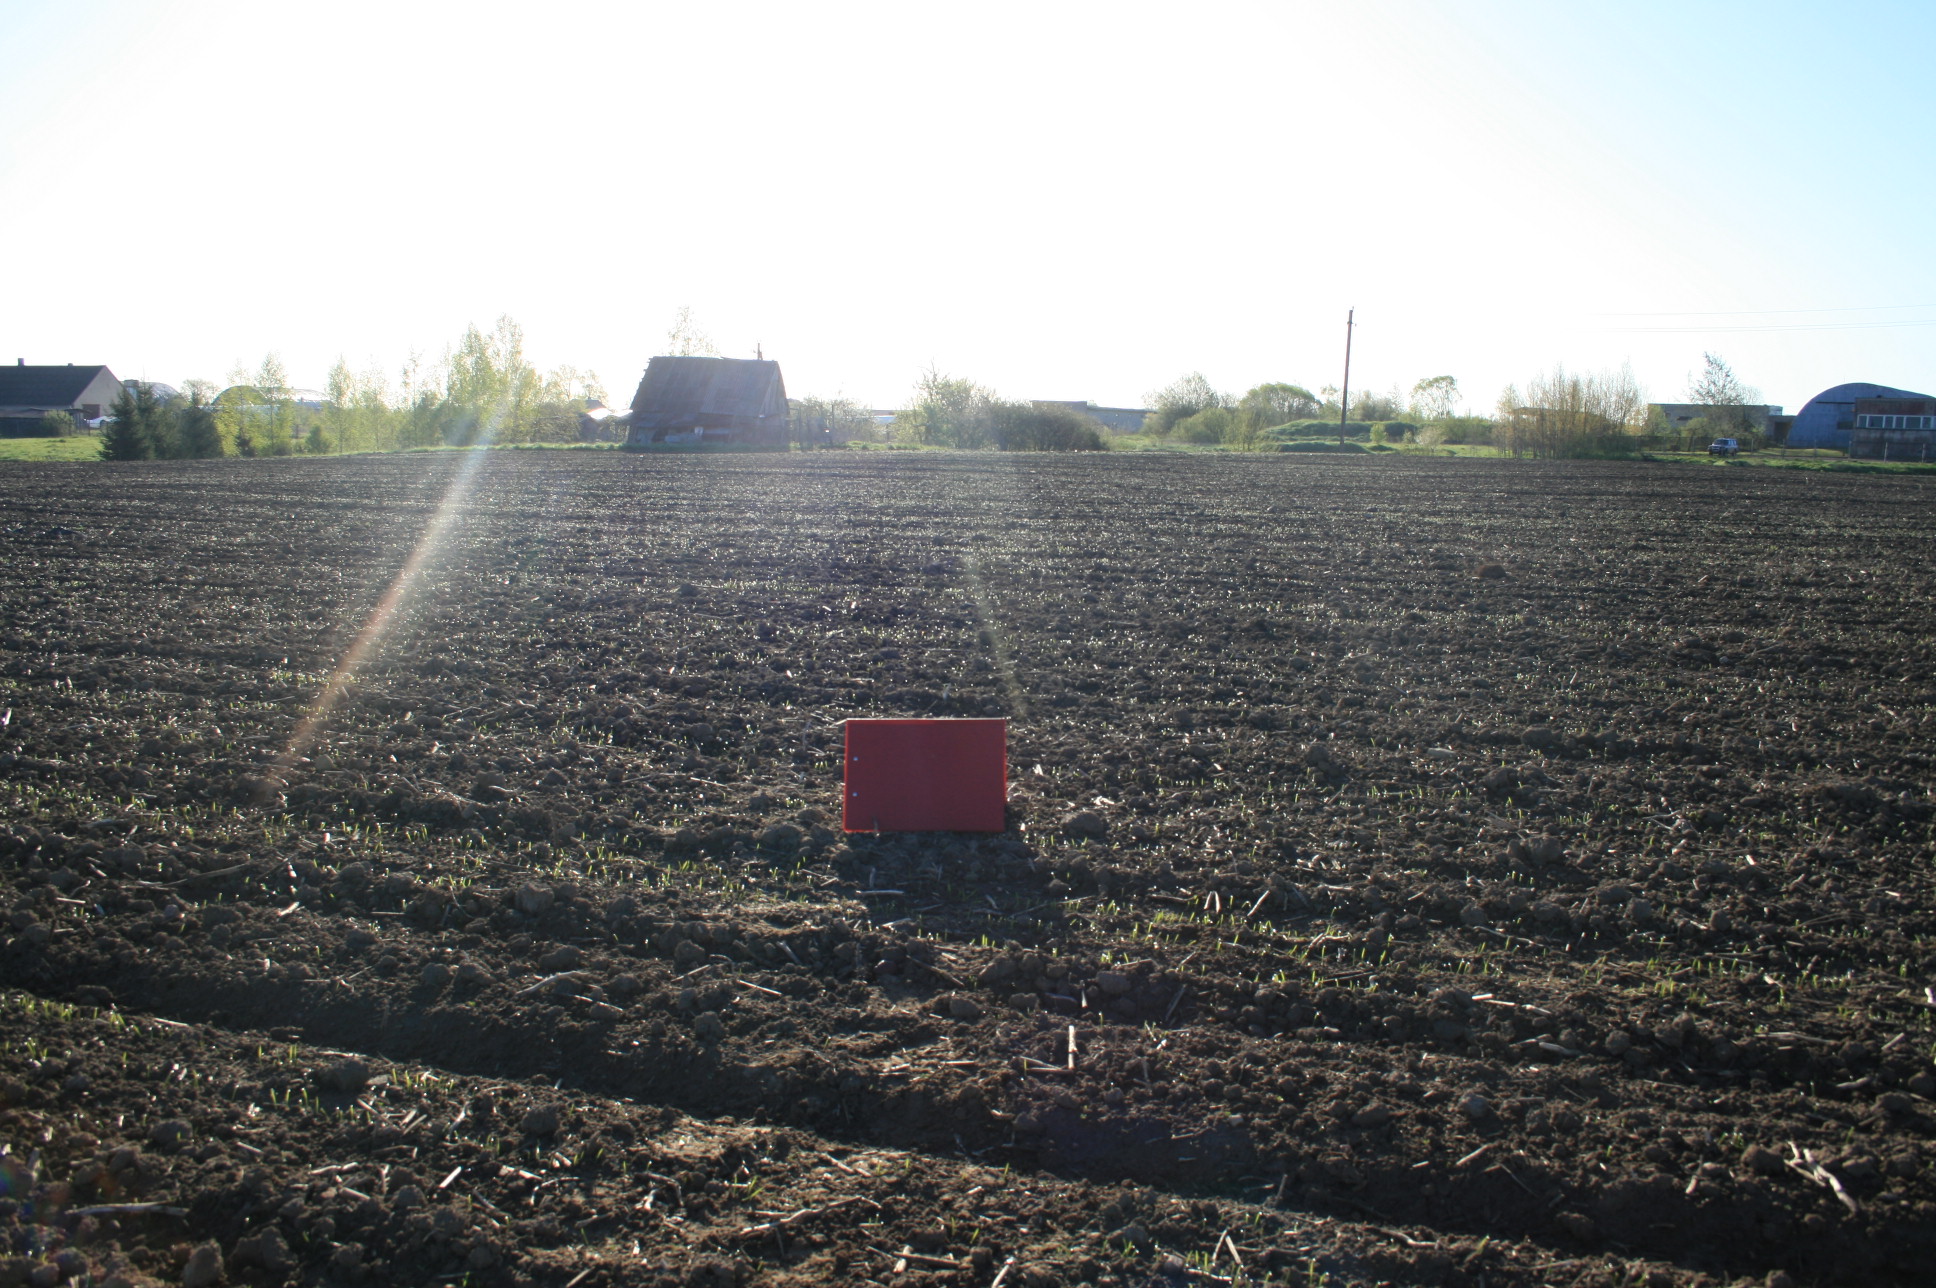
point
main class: Cropland
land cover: Common wheat
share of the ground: 10 - 25 %
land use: Agriculture (excluding fallow land and kitchen gardens)
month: May
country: LT
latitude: 56.2696
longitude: 21.4915
